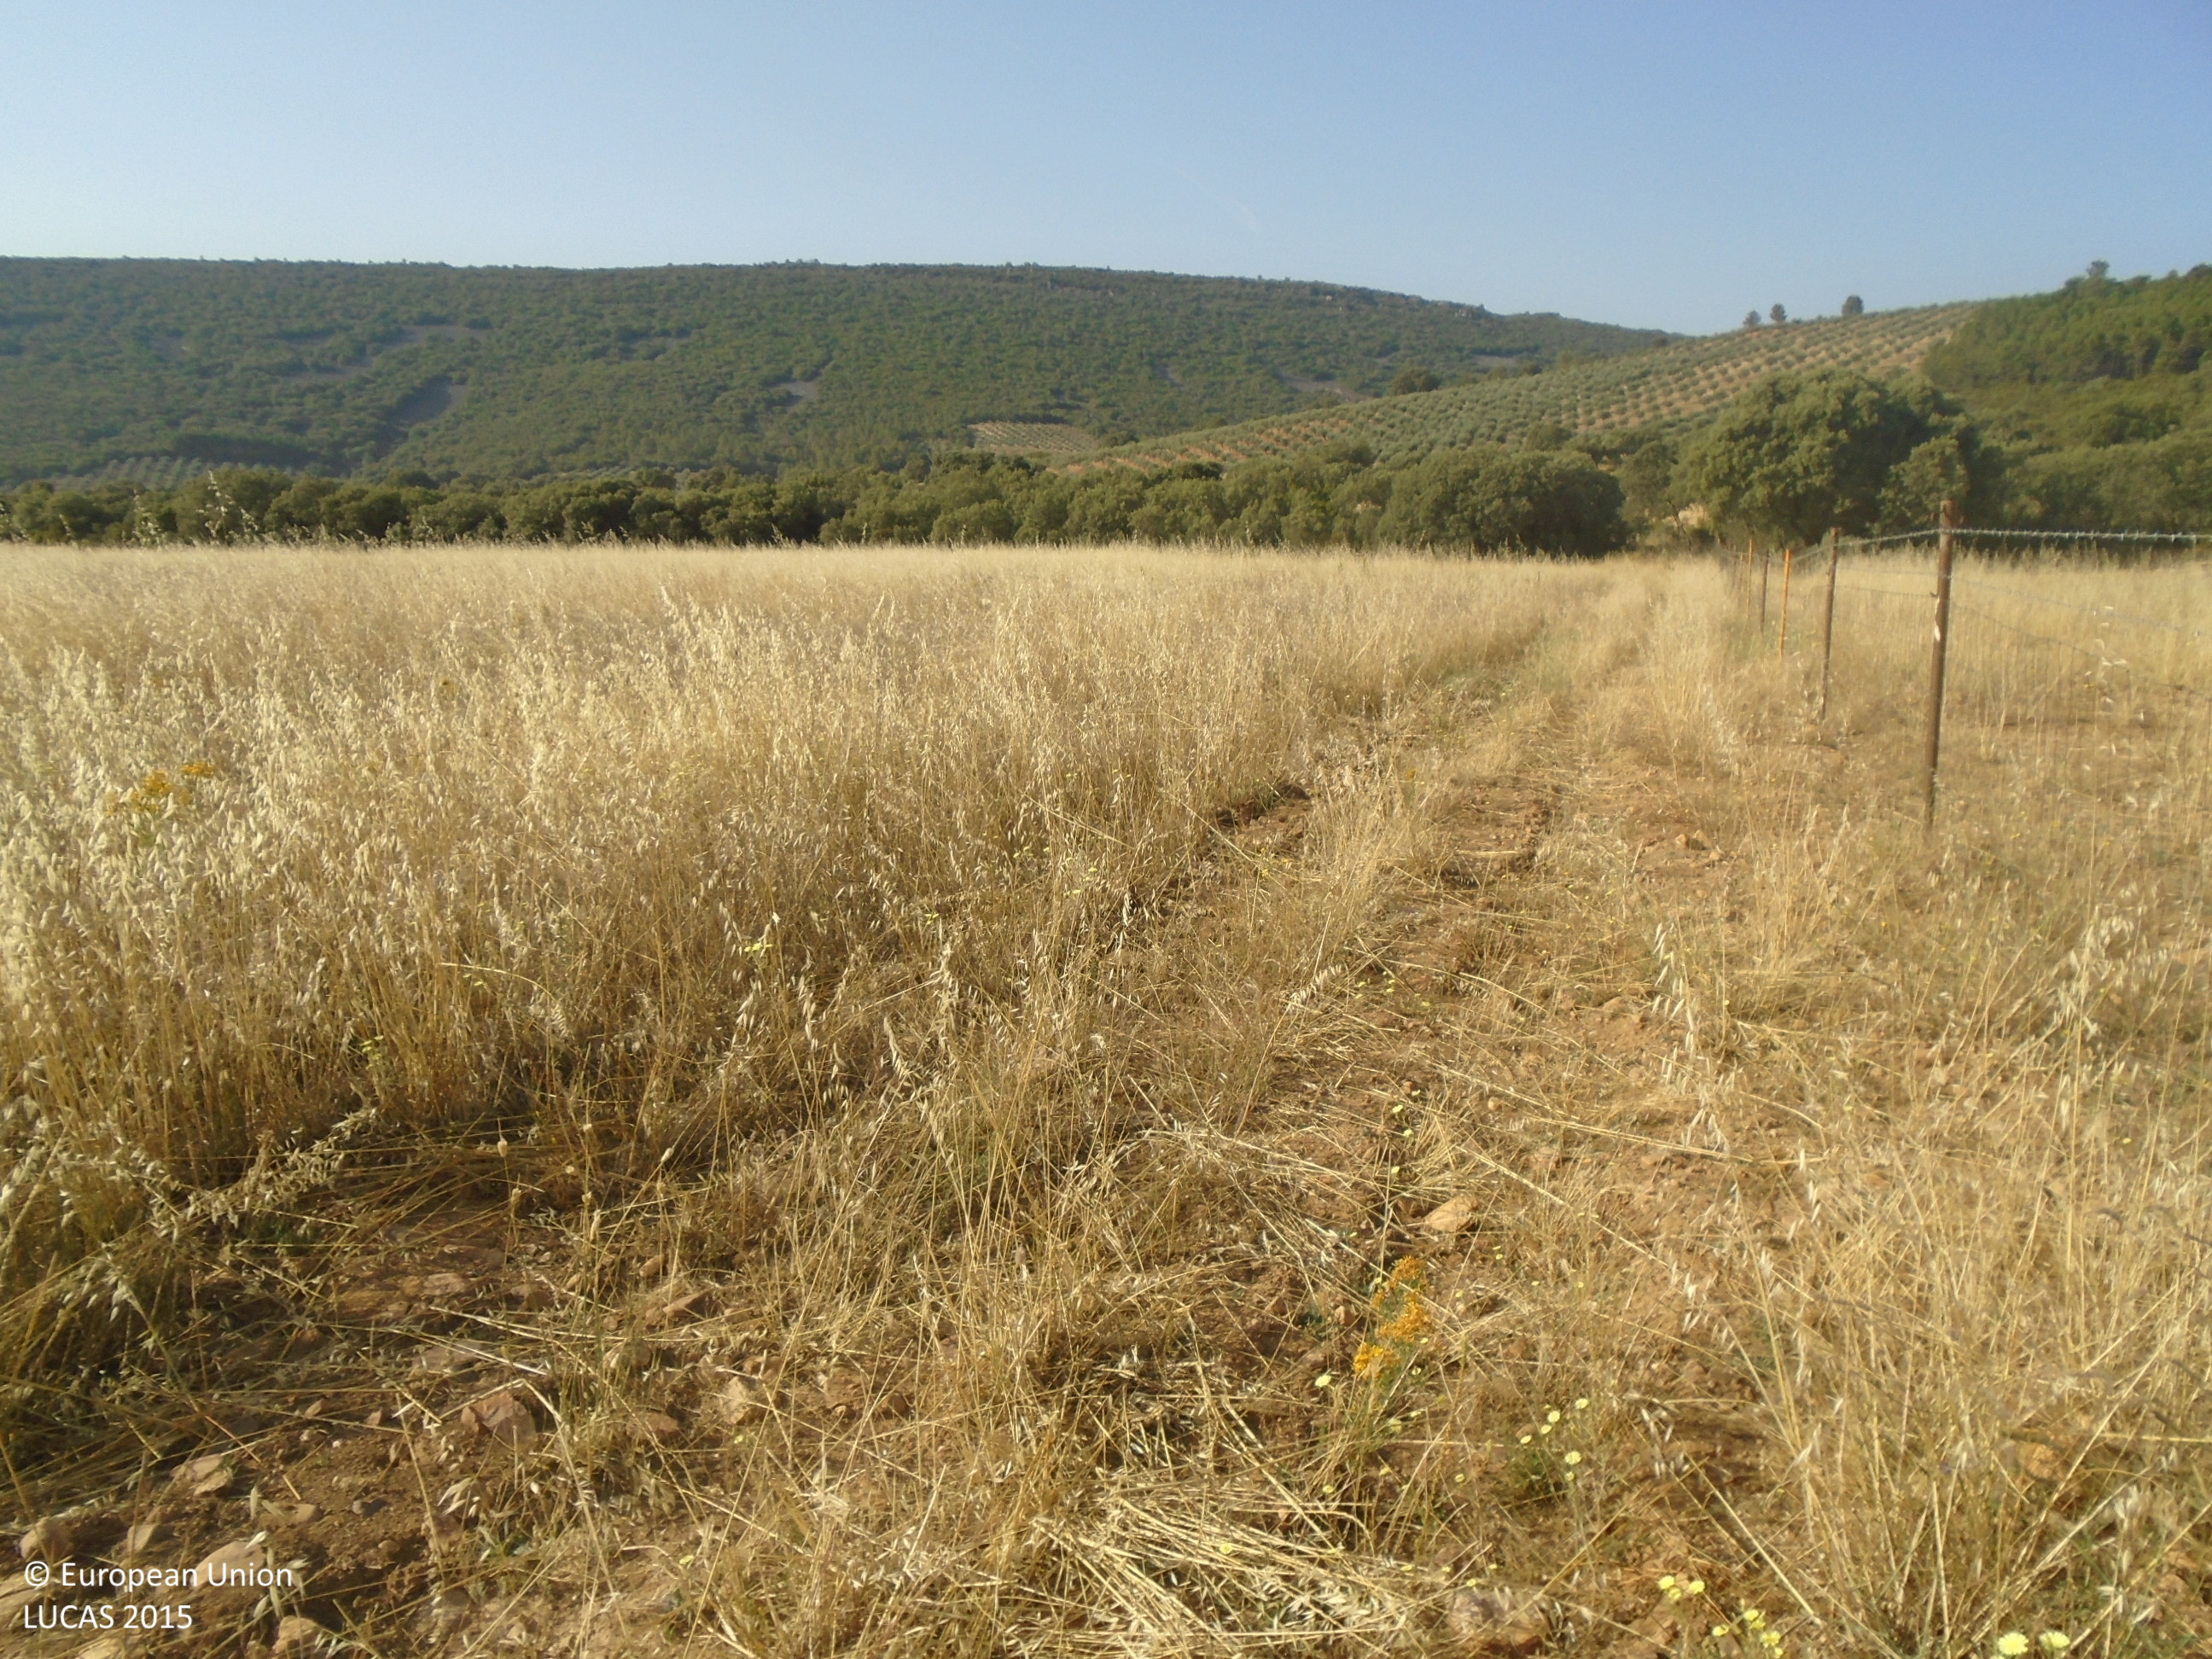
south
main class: Grassland
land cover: Spontaneously vegetated surfaces
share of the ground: > 75 %
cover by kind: herbaceous plants 100 %
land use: Fallow land
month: July
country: ES
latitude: 39.3312
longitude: -4.6174
